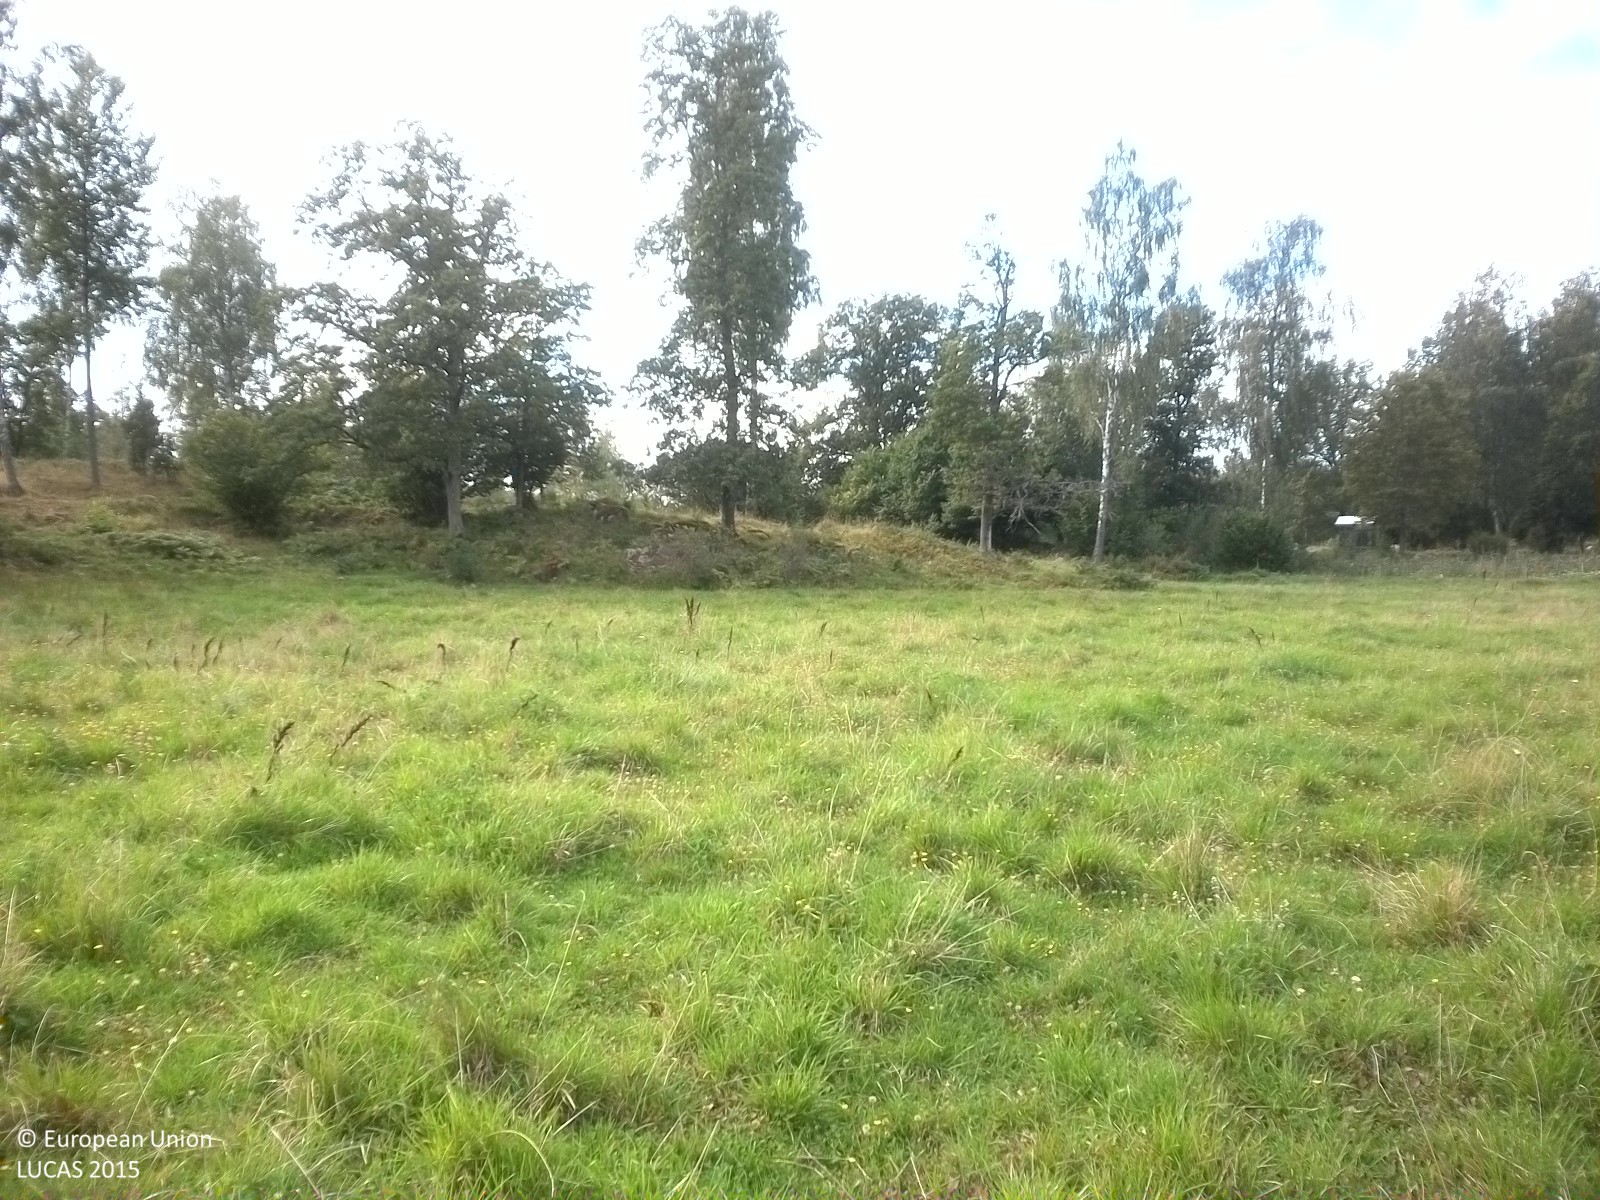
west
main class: Grassland
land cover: Grassland without tree/shrub cover
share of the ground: > 75 %
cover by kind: herbaceous plants 100 %
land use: Agriculture (excluding fallow land and kitchen gardens)
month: August
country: SE
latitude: 59.3165
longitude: 15.9129
